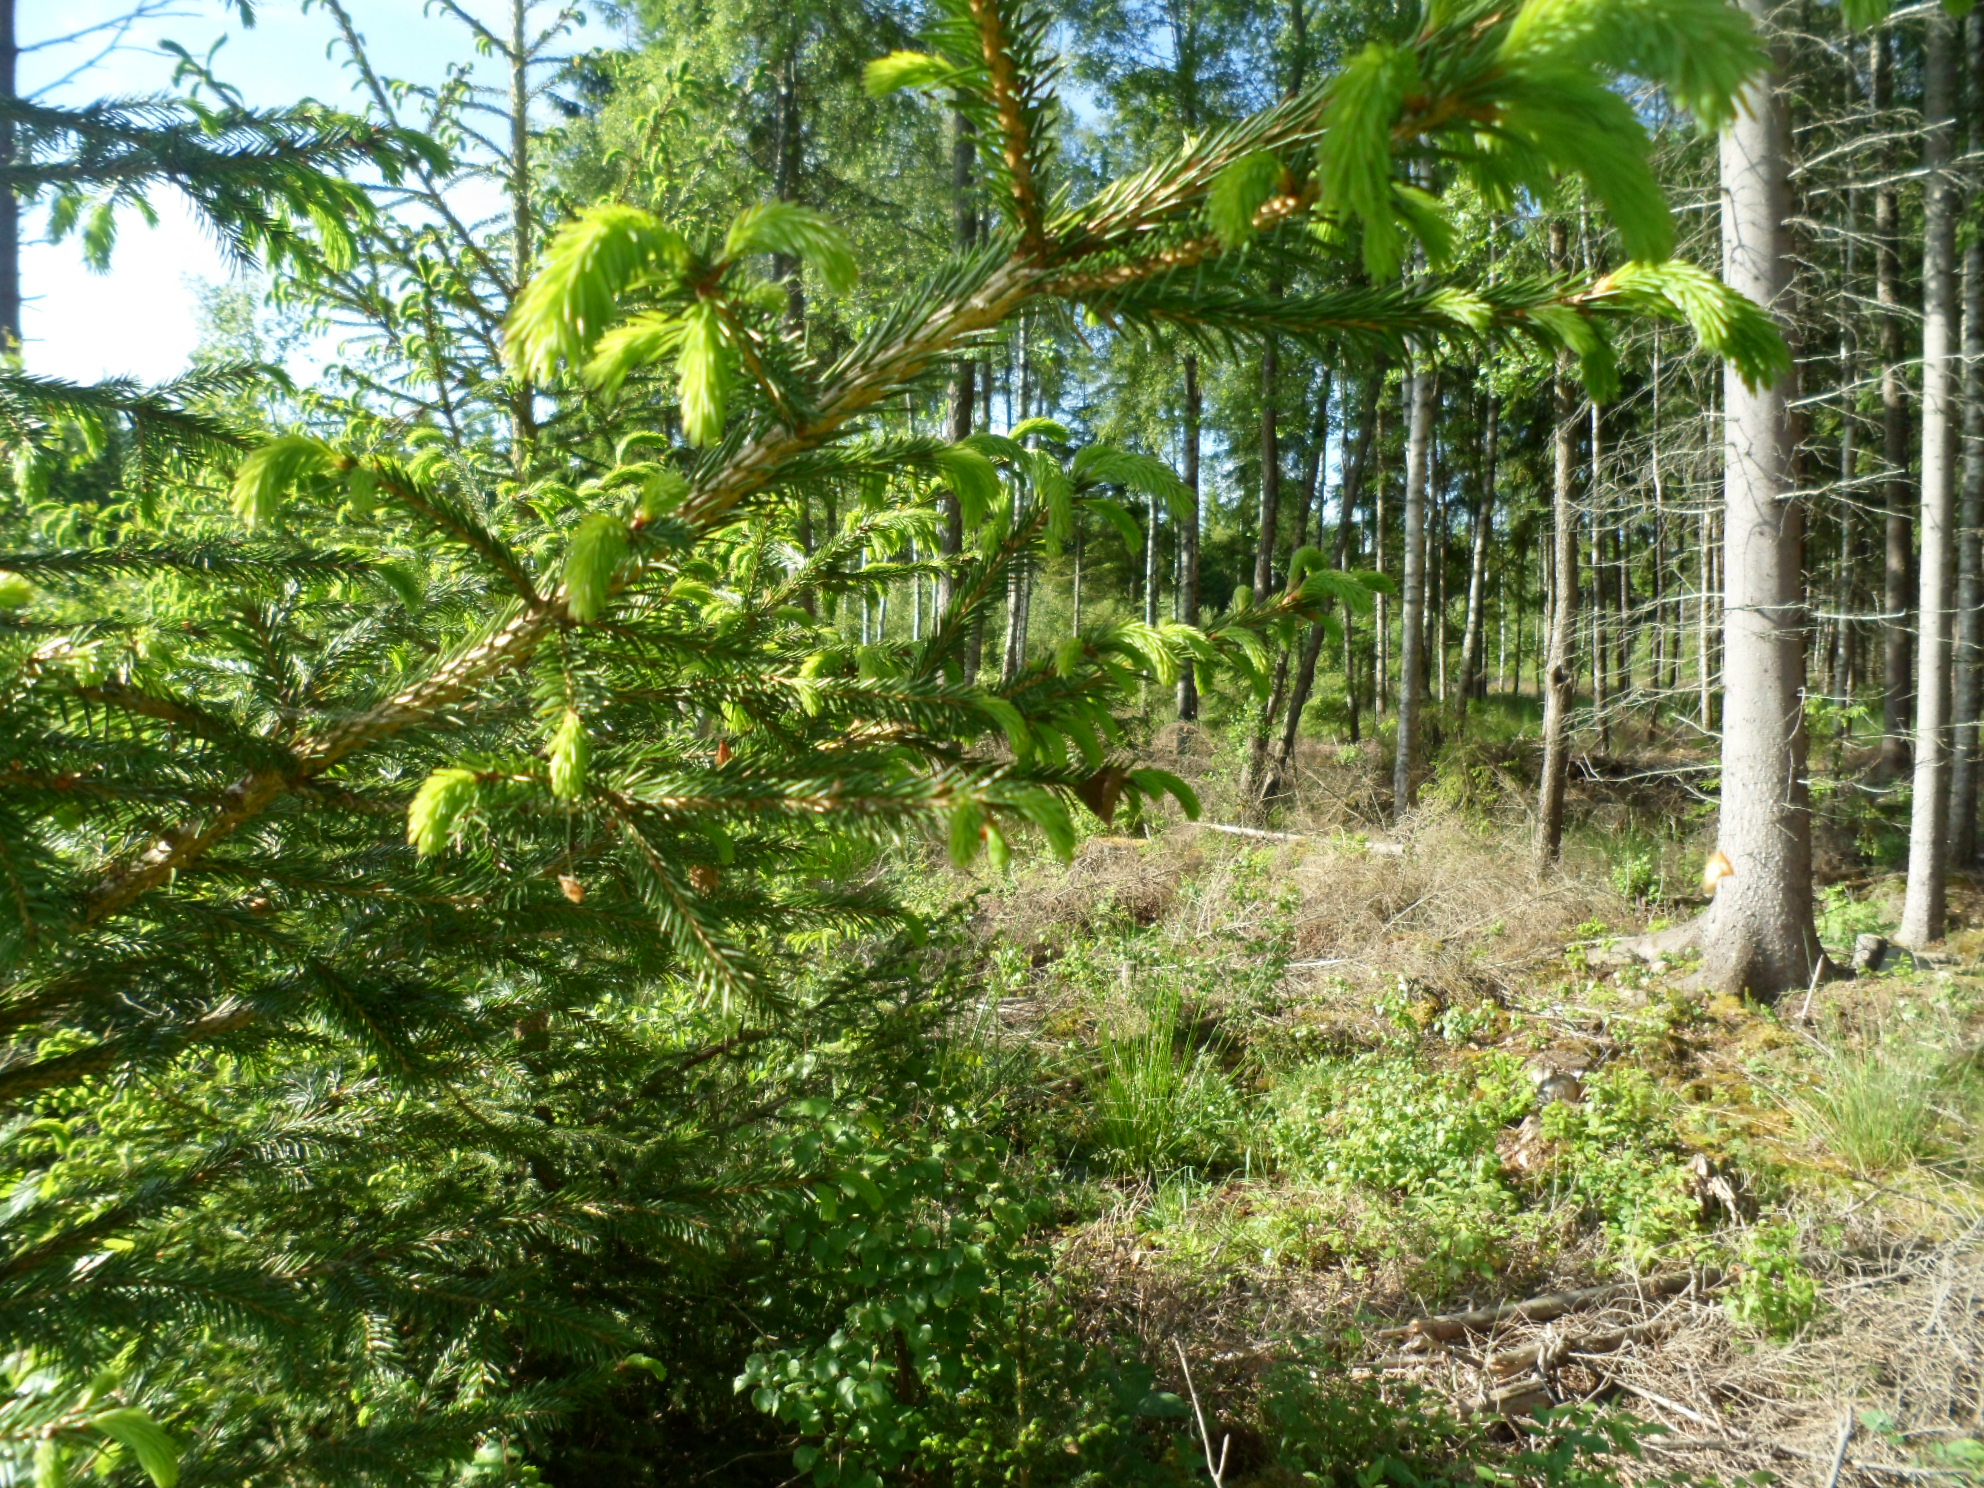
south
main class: Woodland
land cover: Spruce dominated mixed woodland
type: boreal forest
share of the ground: 50 - 75 %
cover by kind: coniferous forest trees 30 %, herbaceous plants 25 %, broadleaved forest trees 20 %, shrubs 20 %, lichens and mosses 5 %
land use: Forestry
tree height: < 5 m
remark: Clear cut
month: June
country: SE
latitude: 57.0852
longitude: 14.8975
